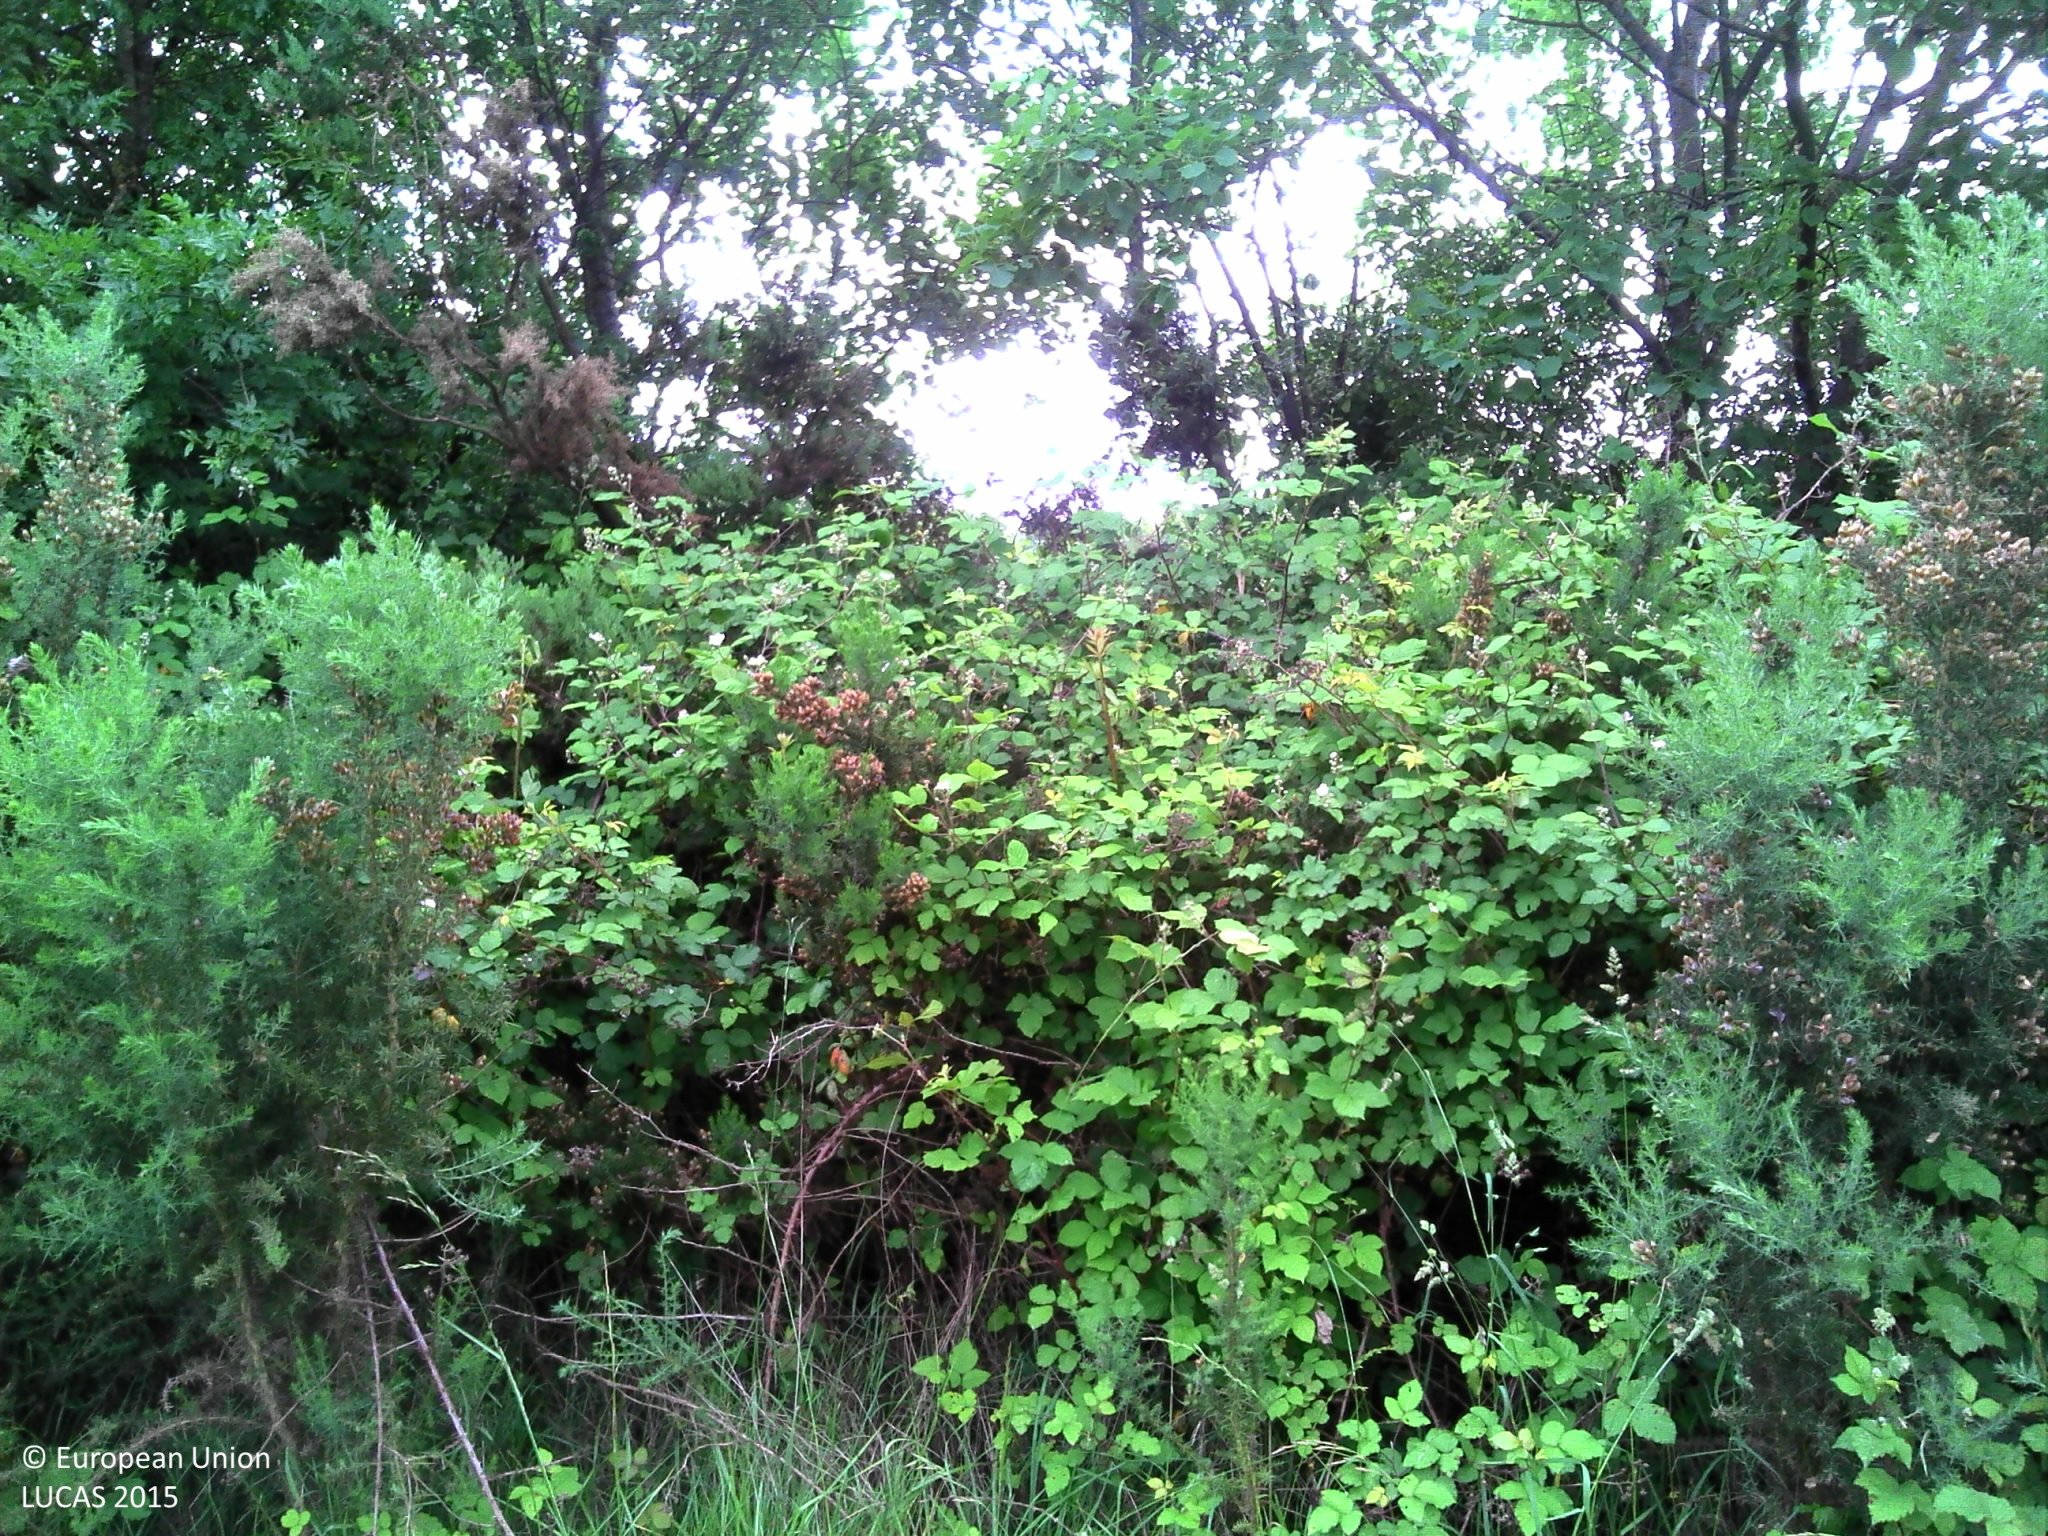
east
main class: Grassland
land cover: Grassland without tree/shrub cover
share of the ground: > 75 %
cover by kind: herbaceous plants 100 %
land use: Agriculture (excluding fallow land and kitchen gardens)
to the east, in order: Grassland without tree/shrub cover; Broadleaved woodland; Ditches and canals; Other leguminous and mixtures for fodder; Ditches and canals; Grass margins; Tracks; Grass margins; Broadleaved woodland; Artificial constructions in urban areas; Broadleaved woodland
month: June
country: FR
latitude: 47.2277
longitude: -1.2513
